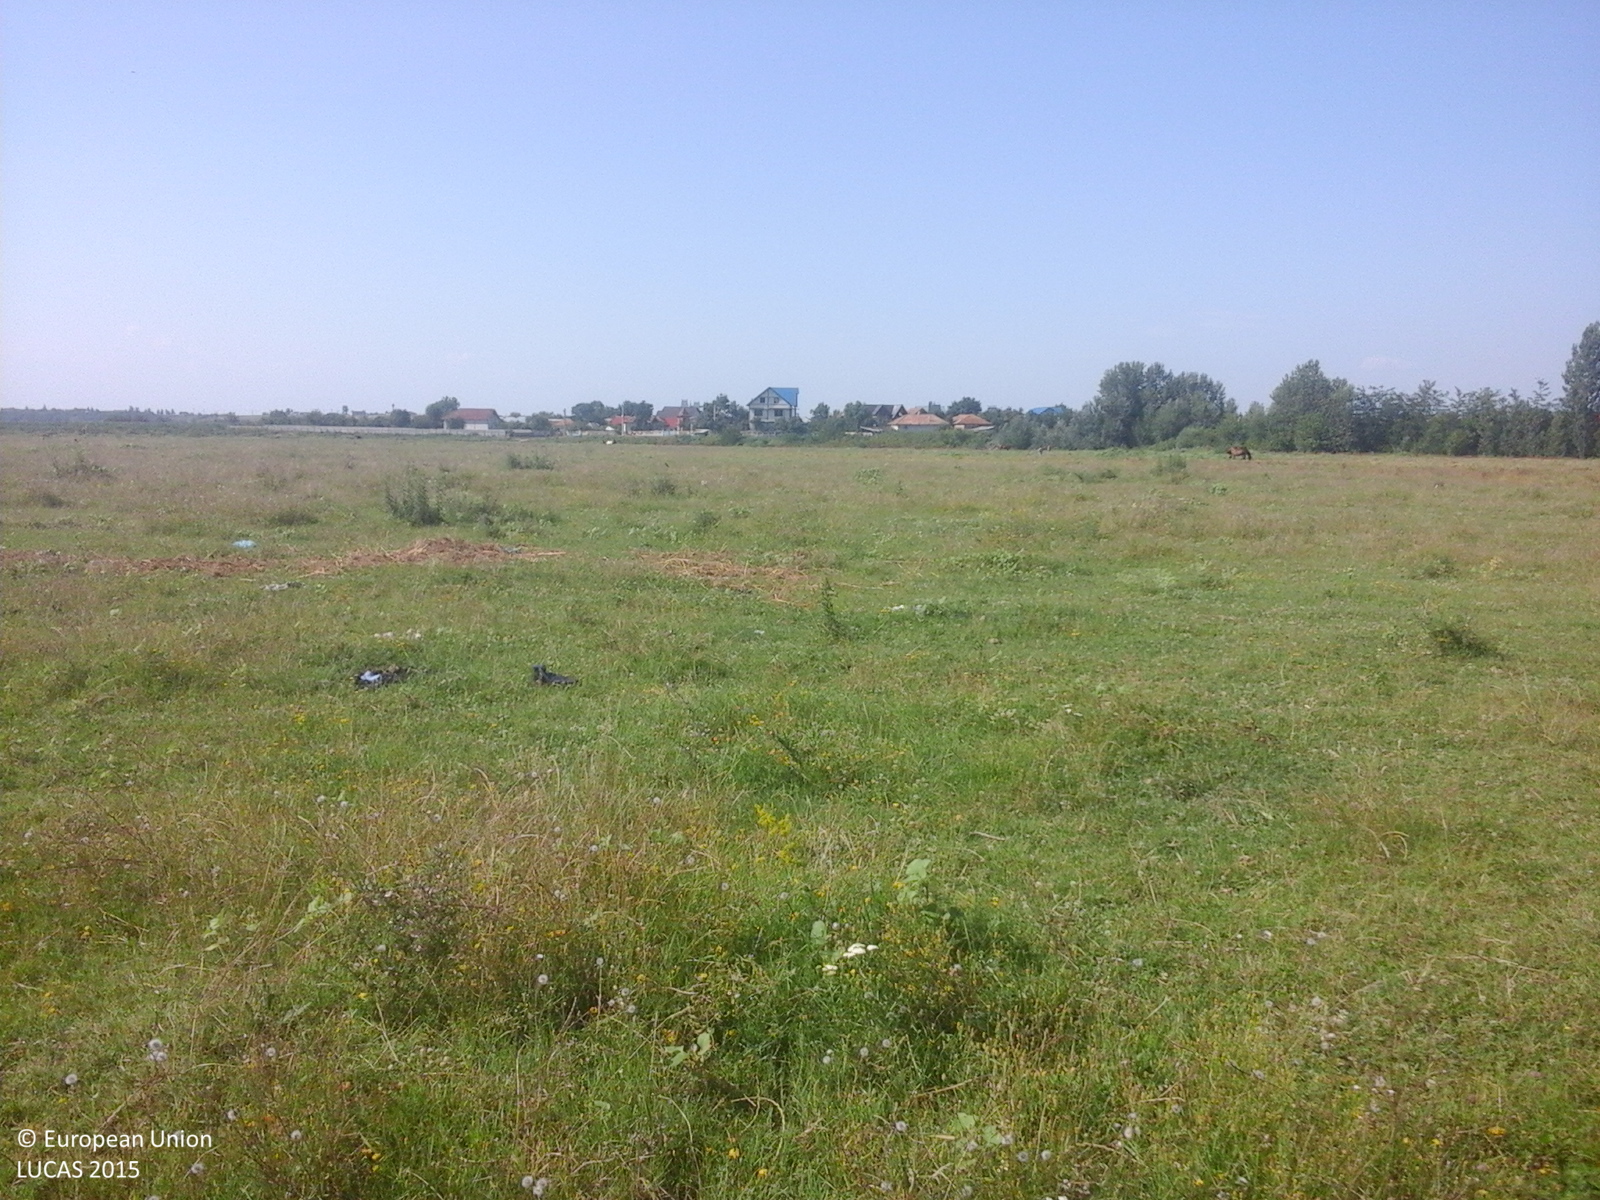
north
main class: Grassland
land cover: Grassland without tree/shrub cover
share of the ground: > 75 %
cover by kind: herbaceous plants 100 %
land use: Agriculture (excluding fallow land and kitchen gardens)
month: July
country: RO
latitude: 44.2500
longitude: 24.3044
